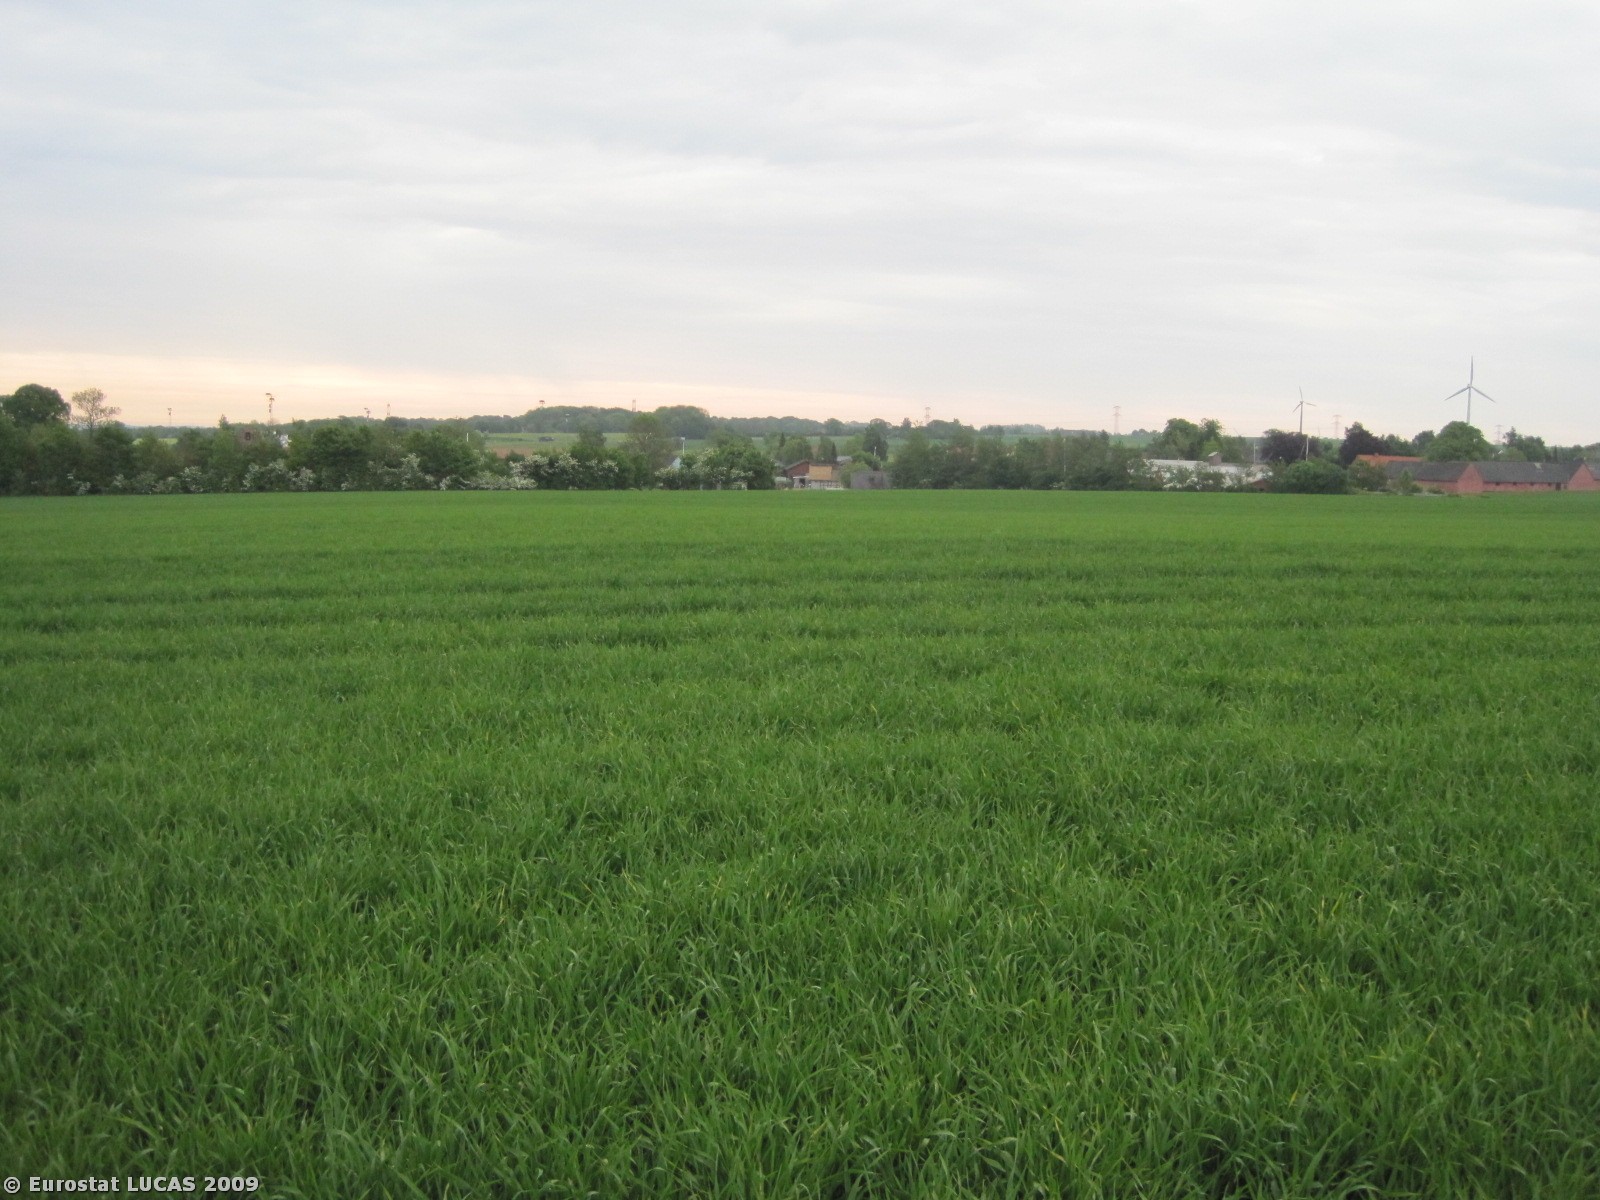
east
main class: Cropland
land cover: Barley
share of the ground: > 75 %
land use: Agriculture (excluding fallow land and kitchen gardens)
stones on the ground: < 10 %
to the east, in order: Barley
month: May
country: DK
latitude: 56.4034
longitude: 9.9838
